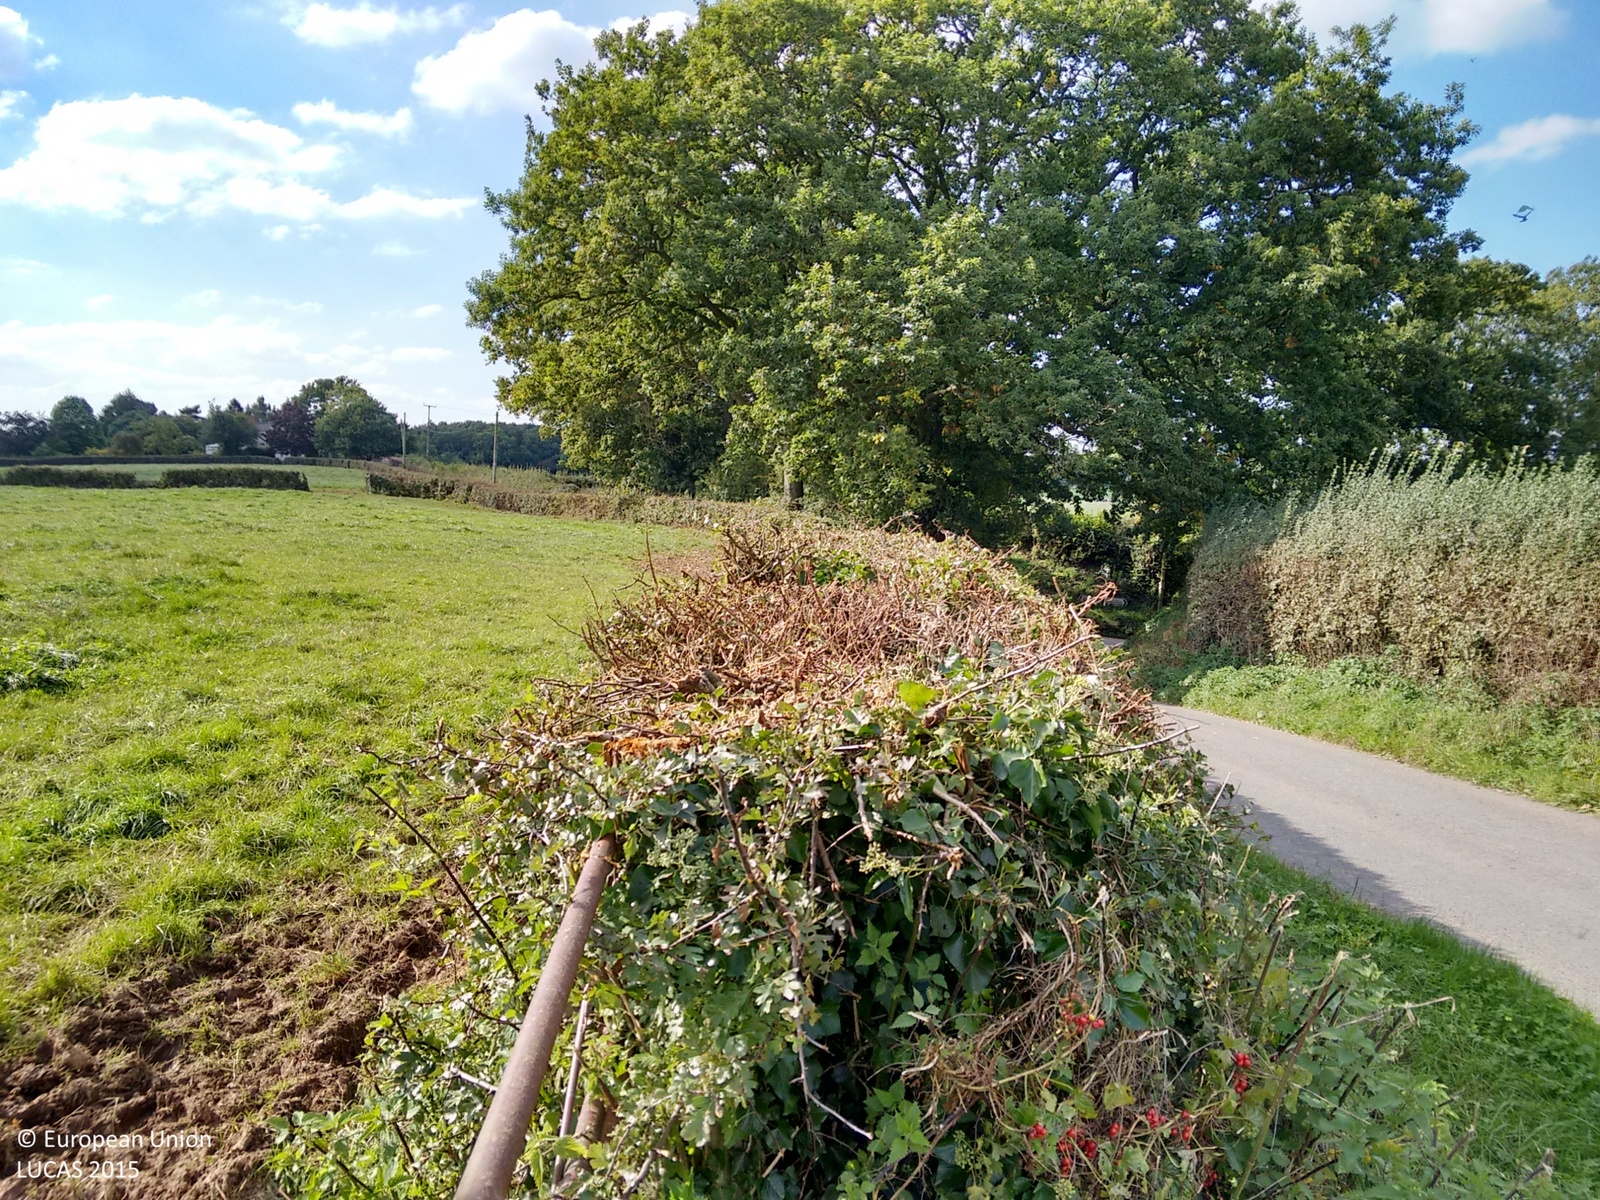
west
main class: Grassland
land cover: Grassland without tree/shrub cover
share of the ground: > 75 %
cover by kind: herbaceous plants 100 %
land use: Agriculture (excluding fallow land and kitchen gardens)
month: September
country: GB
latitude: 51.8526
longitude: -2.3905
